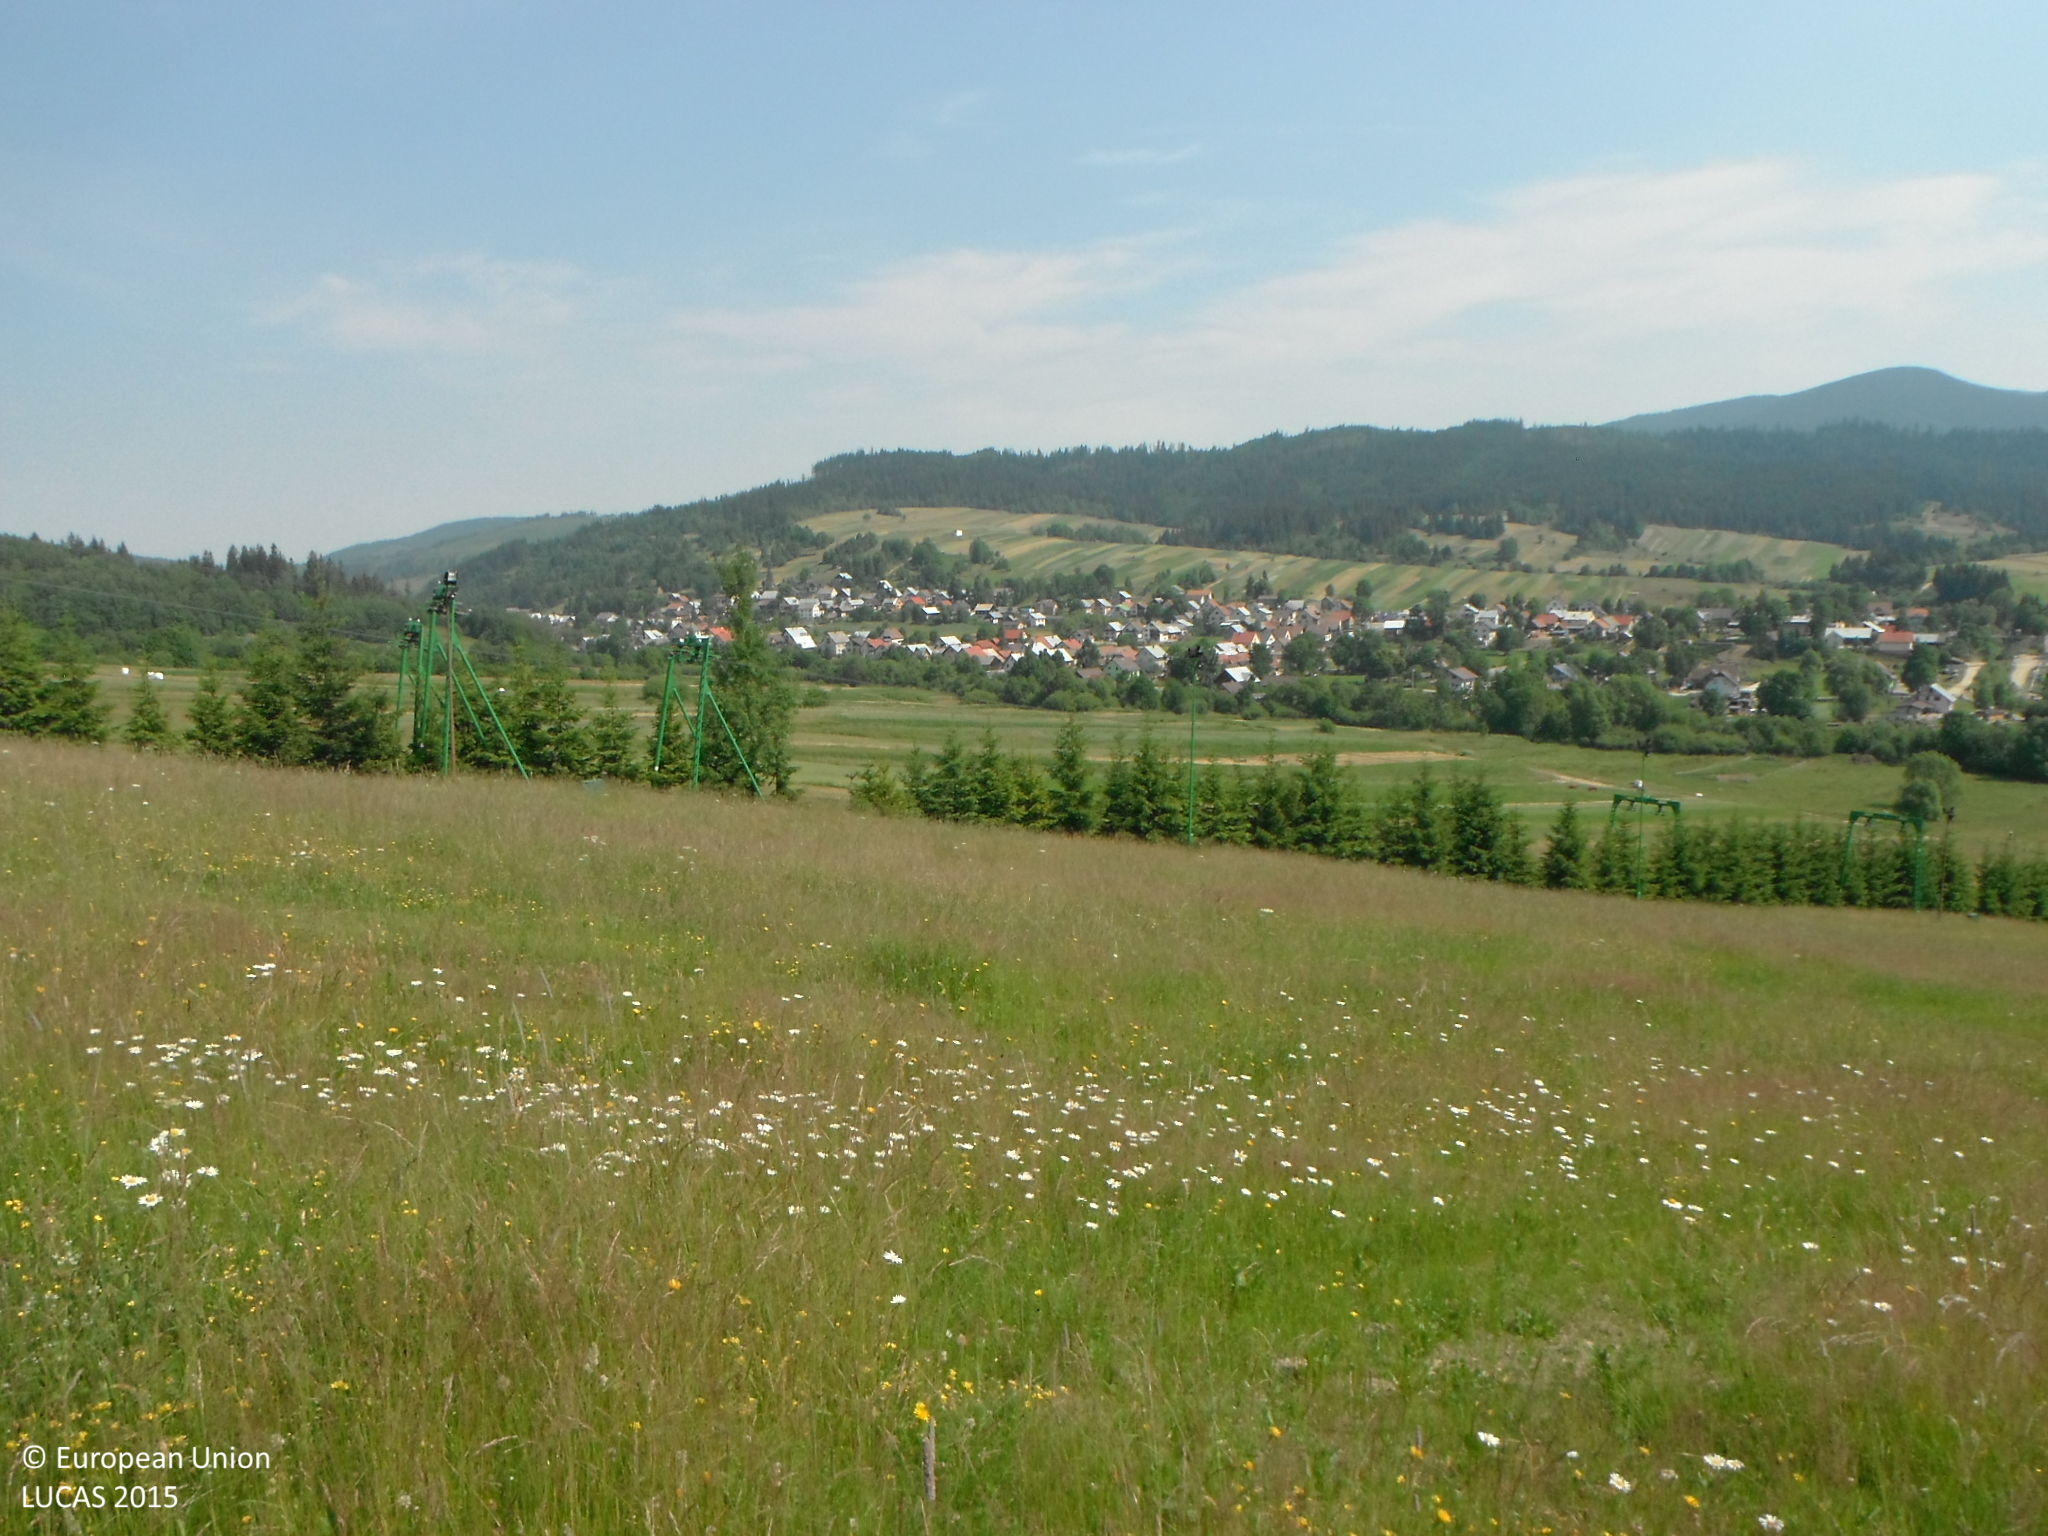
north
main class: Grassland
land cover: Grassland without tree/shrub cover
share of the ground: > 75 %
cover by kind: herbaceous plants 100 %
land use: Agriculture (excluding fallow land and kitchen gardens)
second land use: Sport
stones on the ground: < 10 %
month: July
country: SK
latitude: 49.5207
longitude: 19.4333
